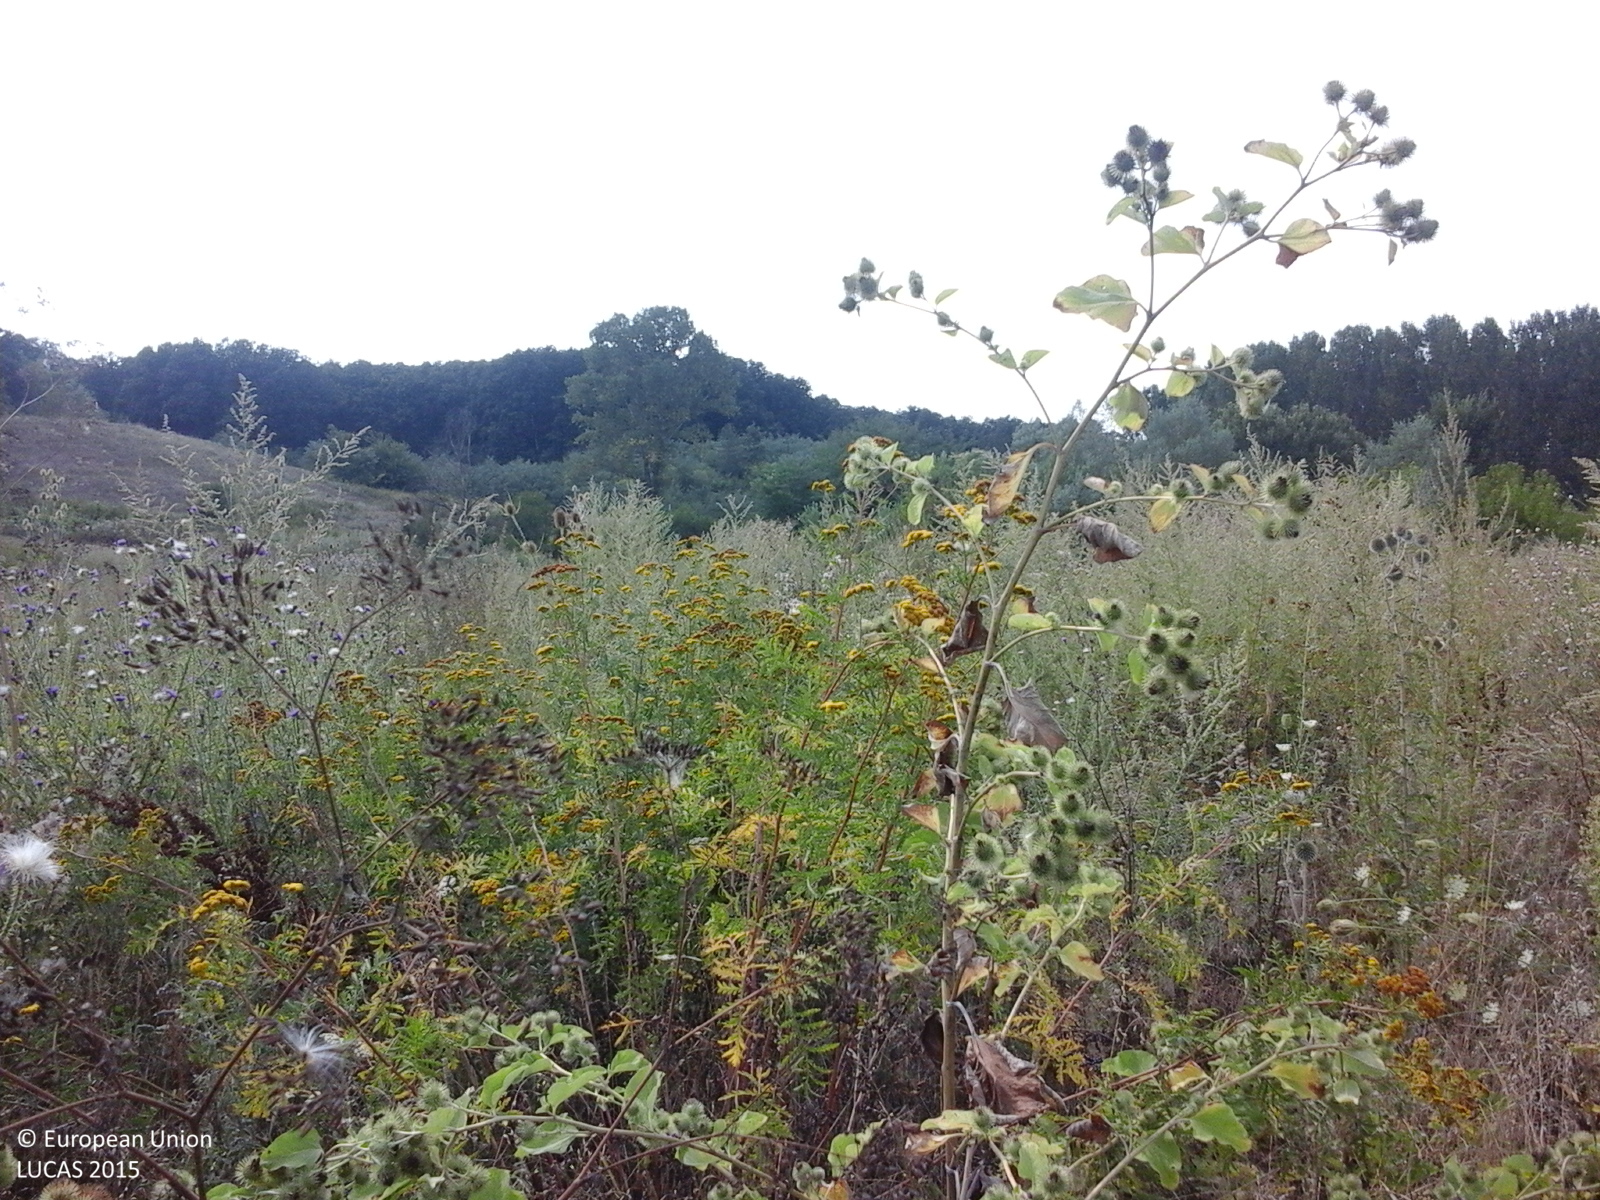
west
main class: Grassland
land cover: Spontaneously vegetated surfaces
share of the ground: > 75 %
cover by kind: herbaceous plants 100 %
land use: Fallow land
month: August
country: RO
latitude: 44.3231
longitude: 23.3535
